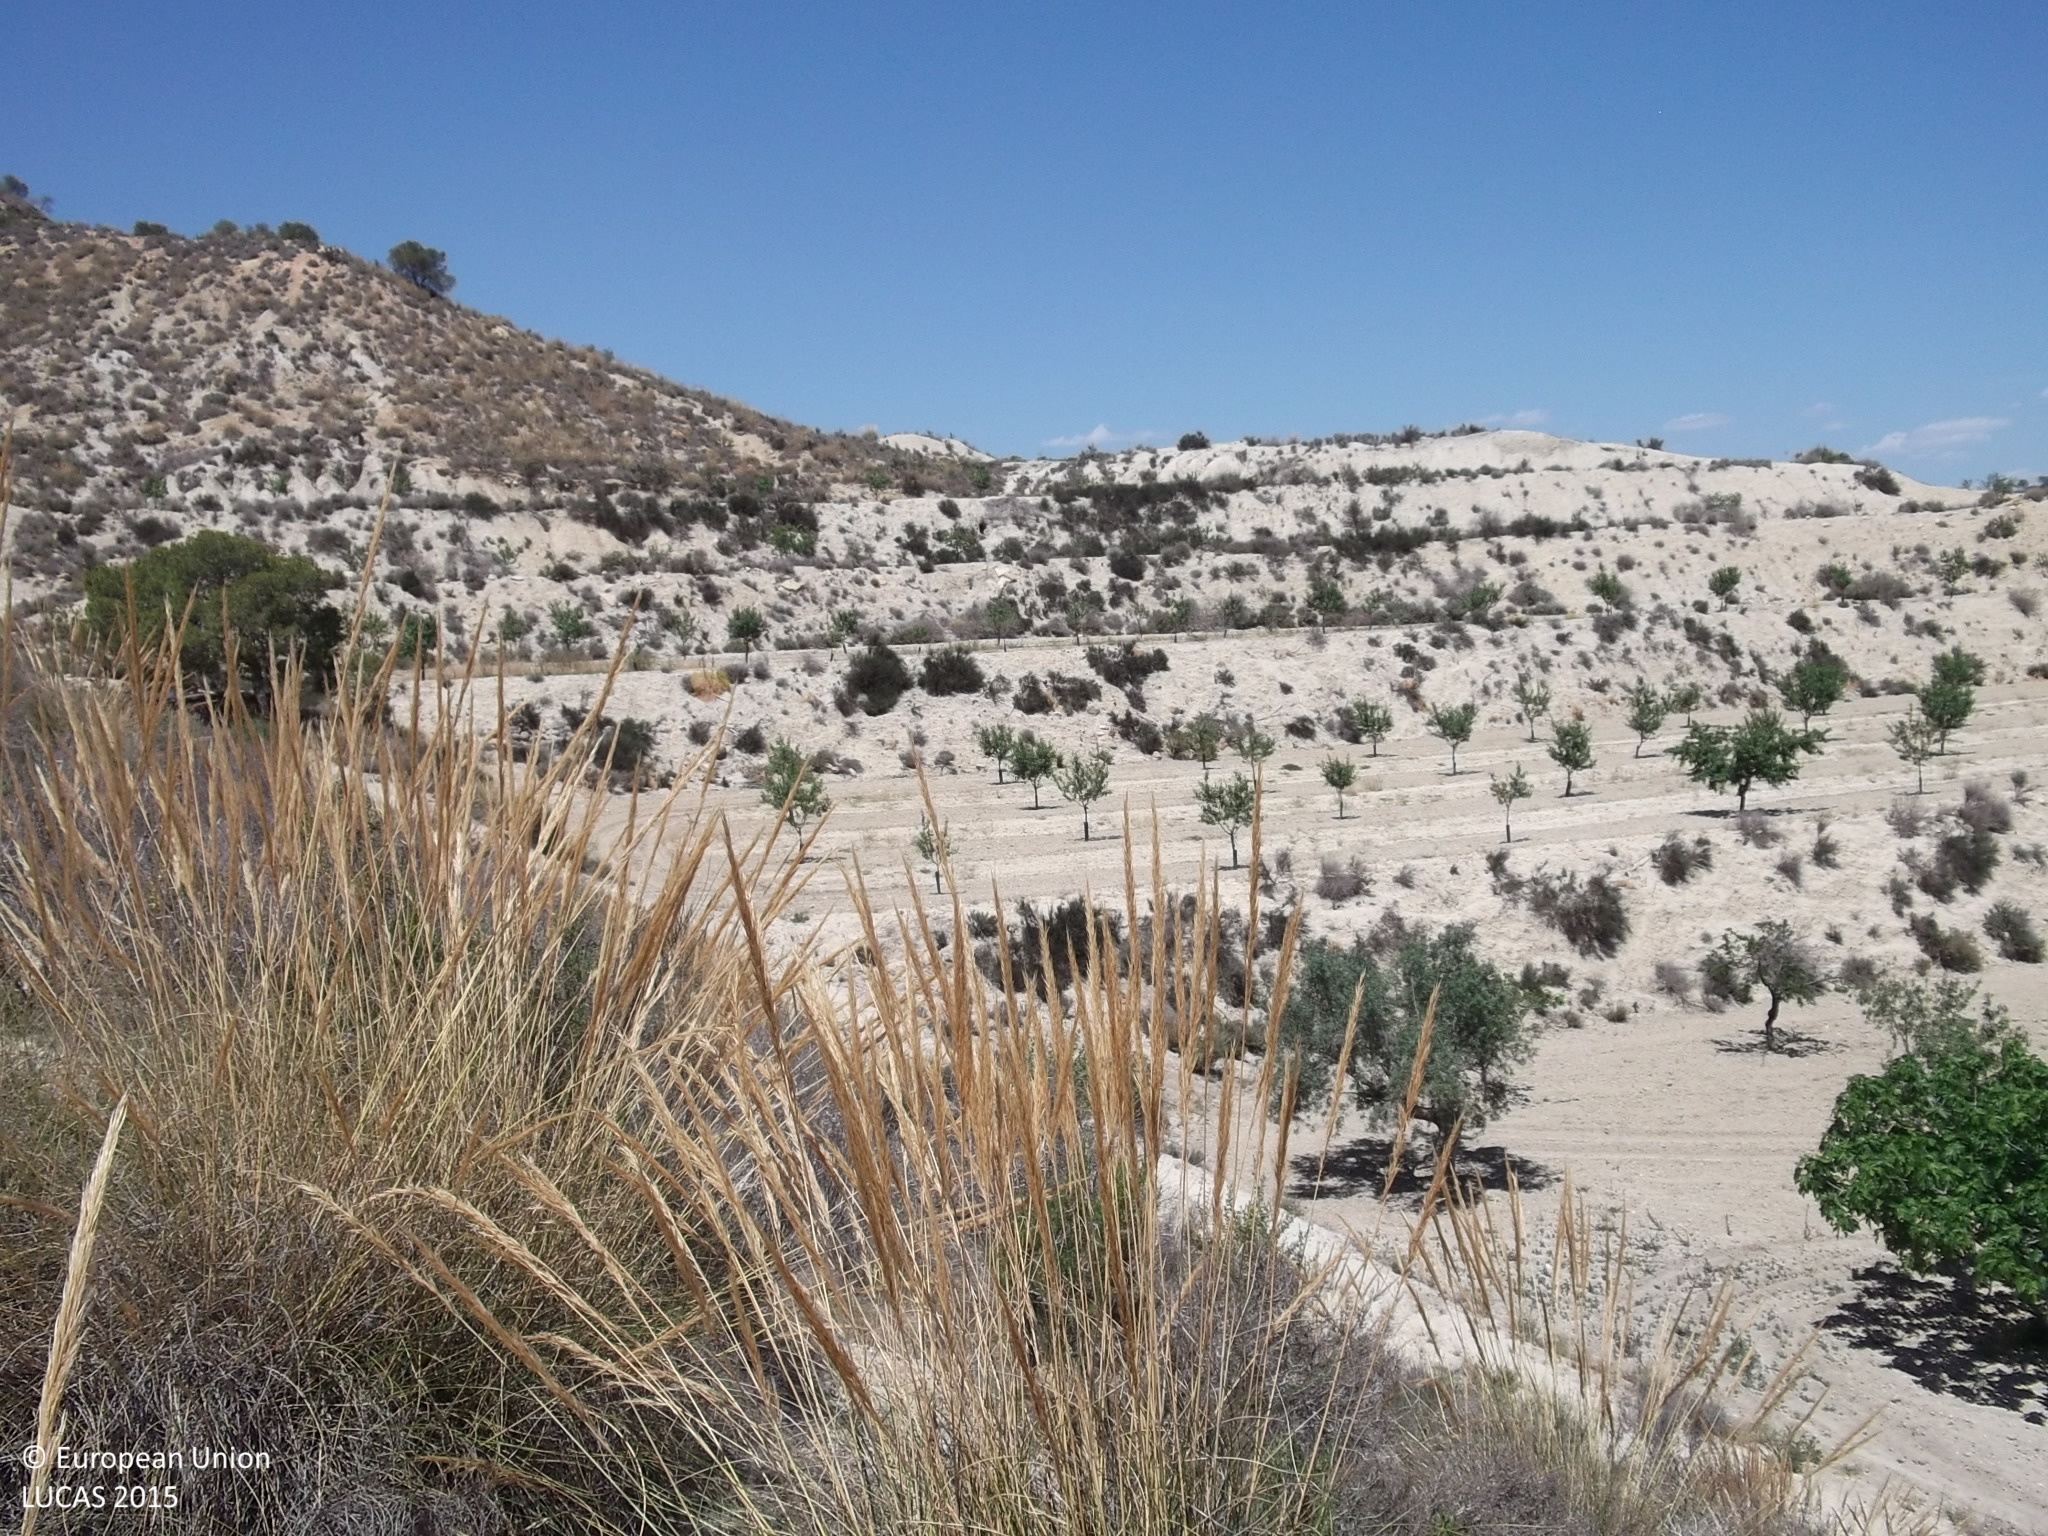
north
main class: Shrubland
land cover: Shrubland without tree cover
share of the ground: 25 - 50 %
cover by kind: shrubs 40 %, consolidated bare surface 40 %, herbaceous plants 20 %
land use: Semi-natural and natural areas not in use
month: May
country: ES
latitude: 38.0141
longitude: -0.9064
